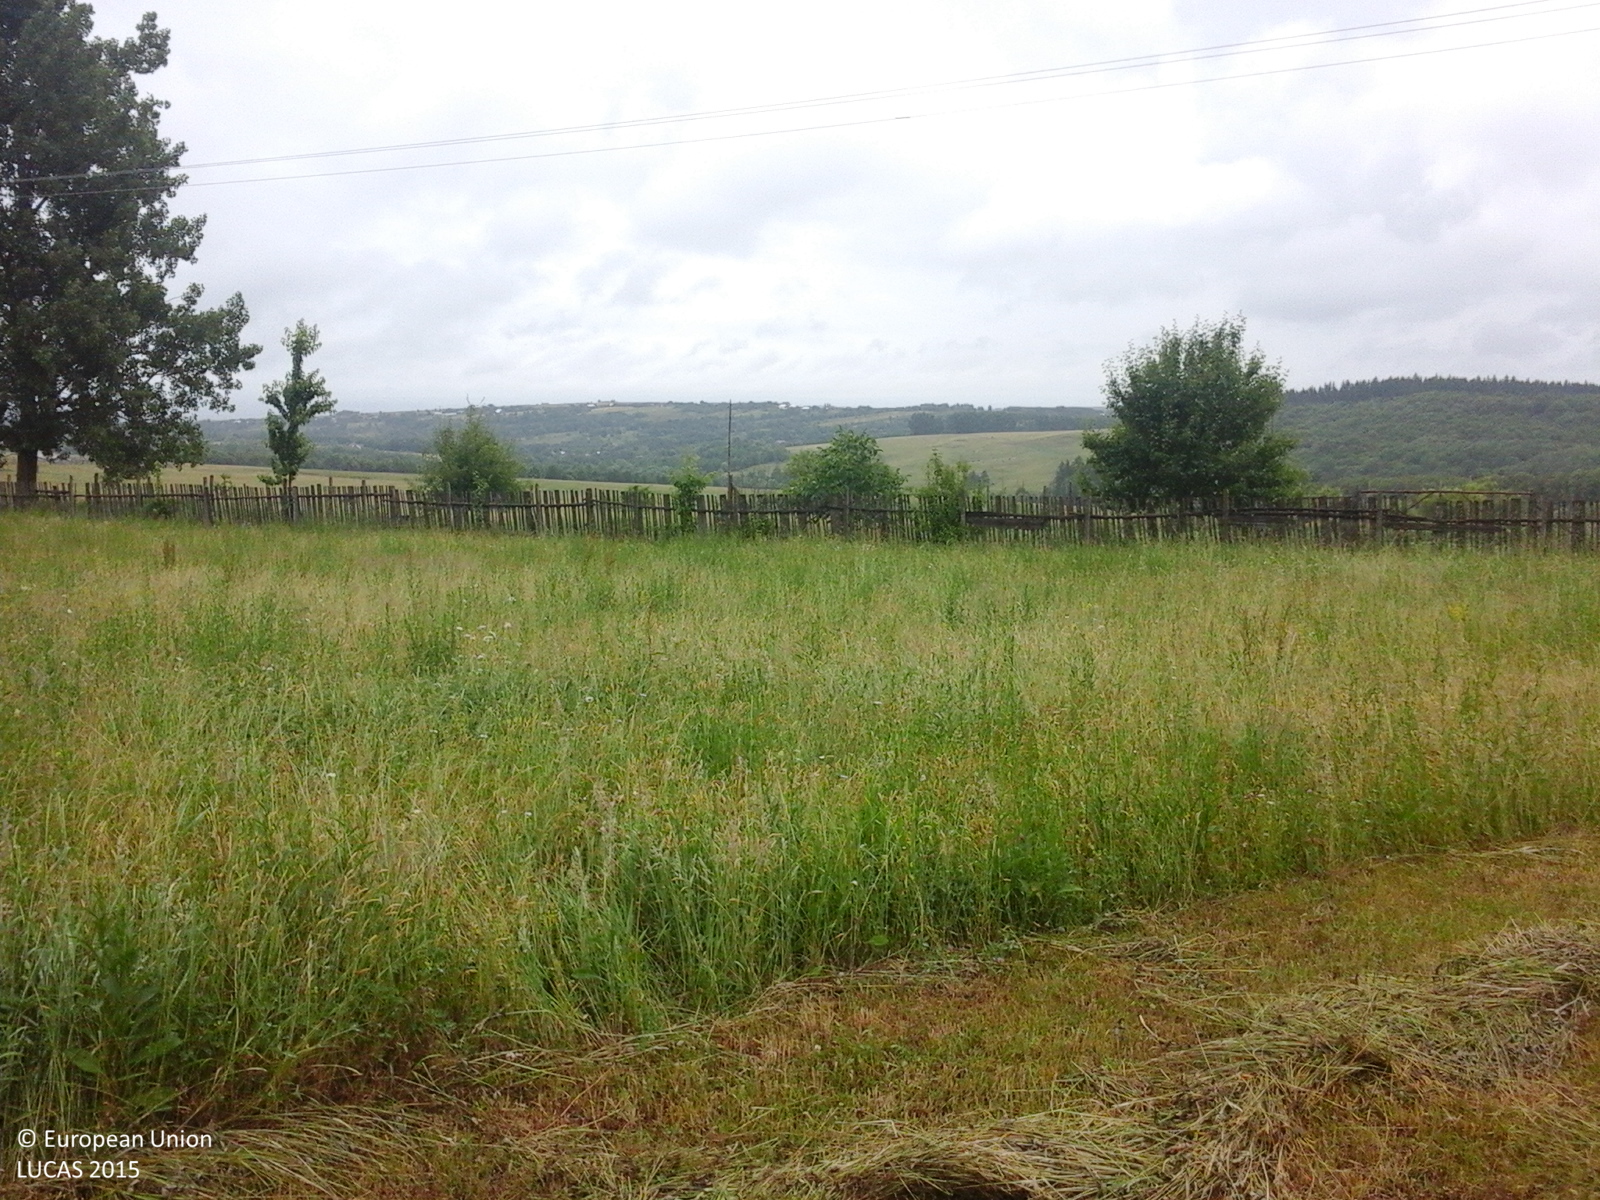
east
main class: Grassland
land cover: Grassland without tree/shrub cover
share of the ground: > 75 %
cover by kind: herbaceous plants 100 %
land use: Agriculture (excluding fallow land and kitchen gardens)
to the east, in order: Grassland without tree/shrub cover; Electric lines; Grassland without tree/shrub cover; Fences; Grass margins; Ditches and canals; Grass margins; Paved roads, cycling and walking lanes; Grass margins; Ditches and canals; Grass margins; Fences; Grassland without tree/shrub cover; Fences; Spontaneously vegetated surfaces; Lines of trees; Grass margins; Ditches and canals; Grassland without tree/shrub cover; Fences; Grassland without tree/shrub cover; Grassland with sparse tree/shrub cover
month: June
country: RO
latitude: 47.3175
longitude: 26.2610
